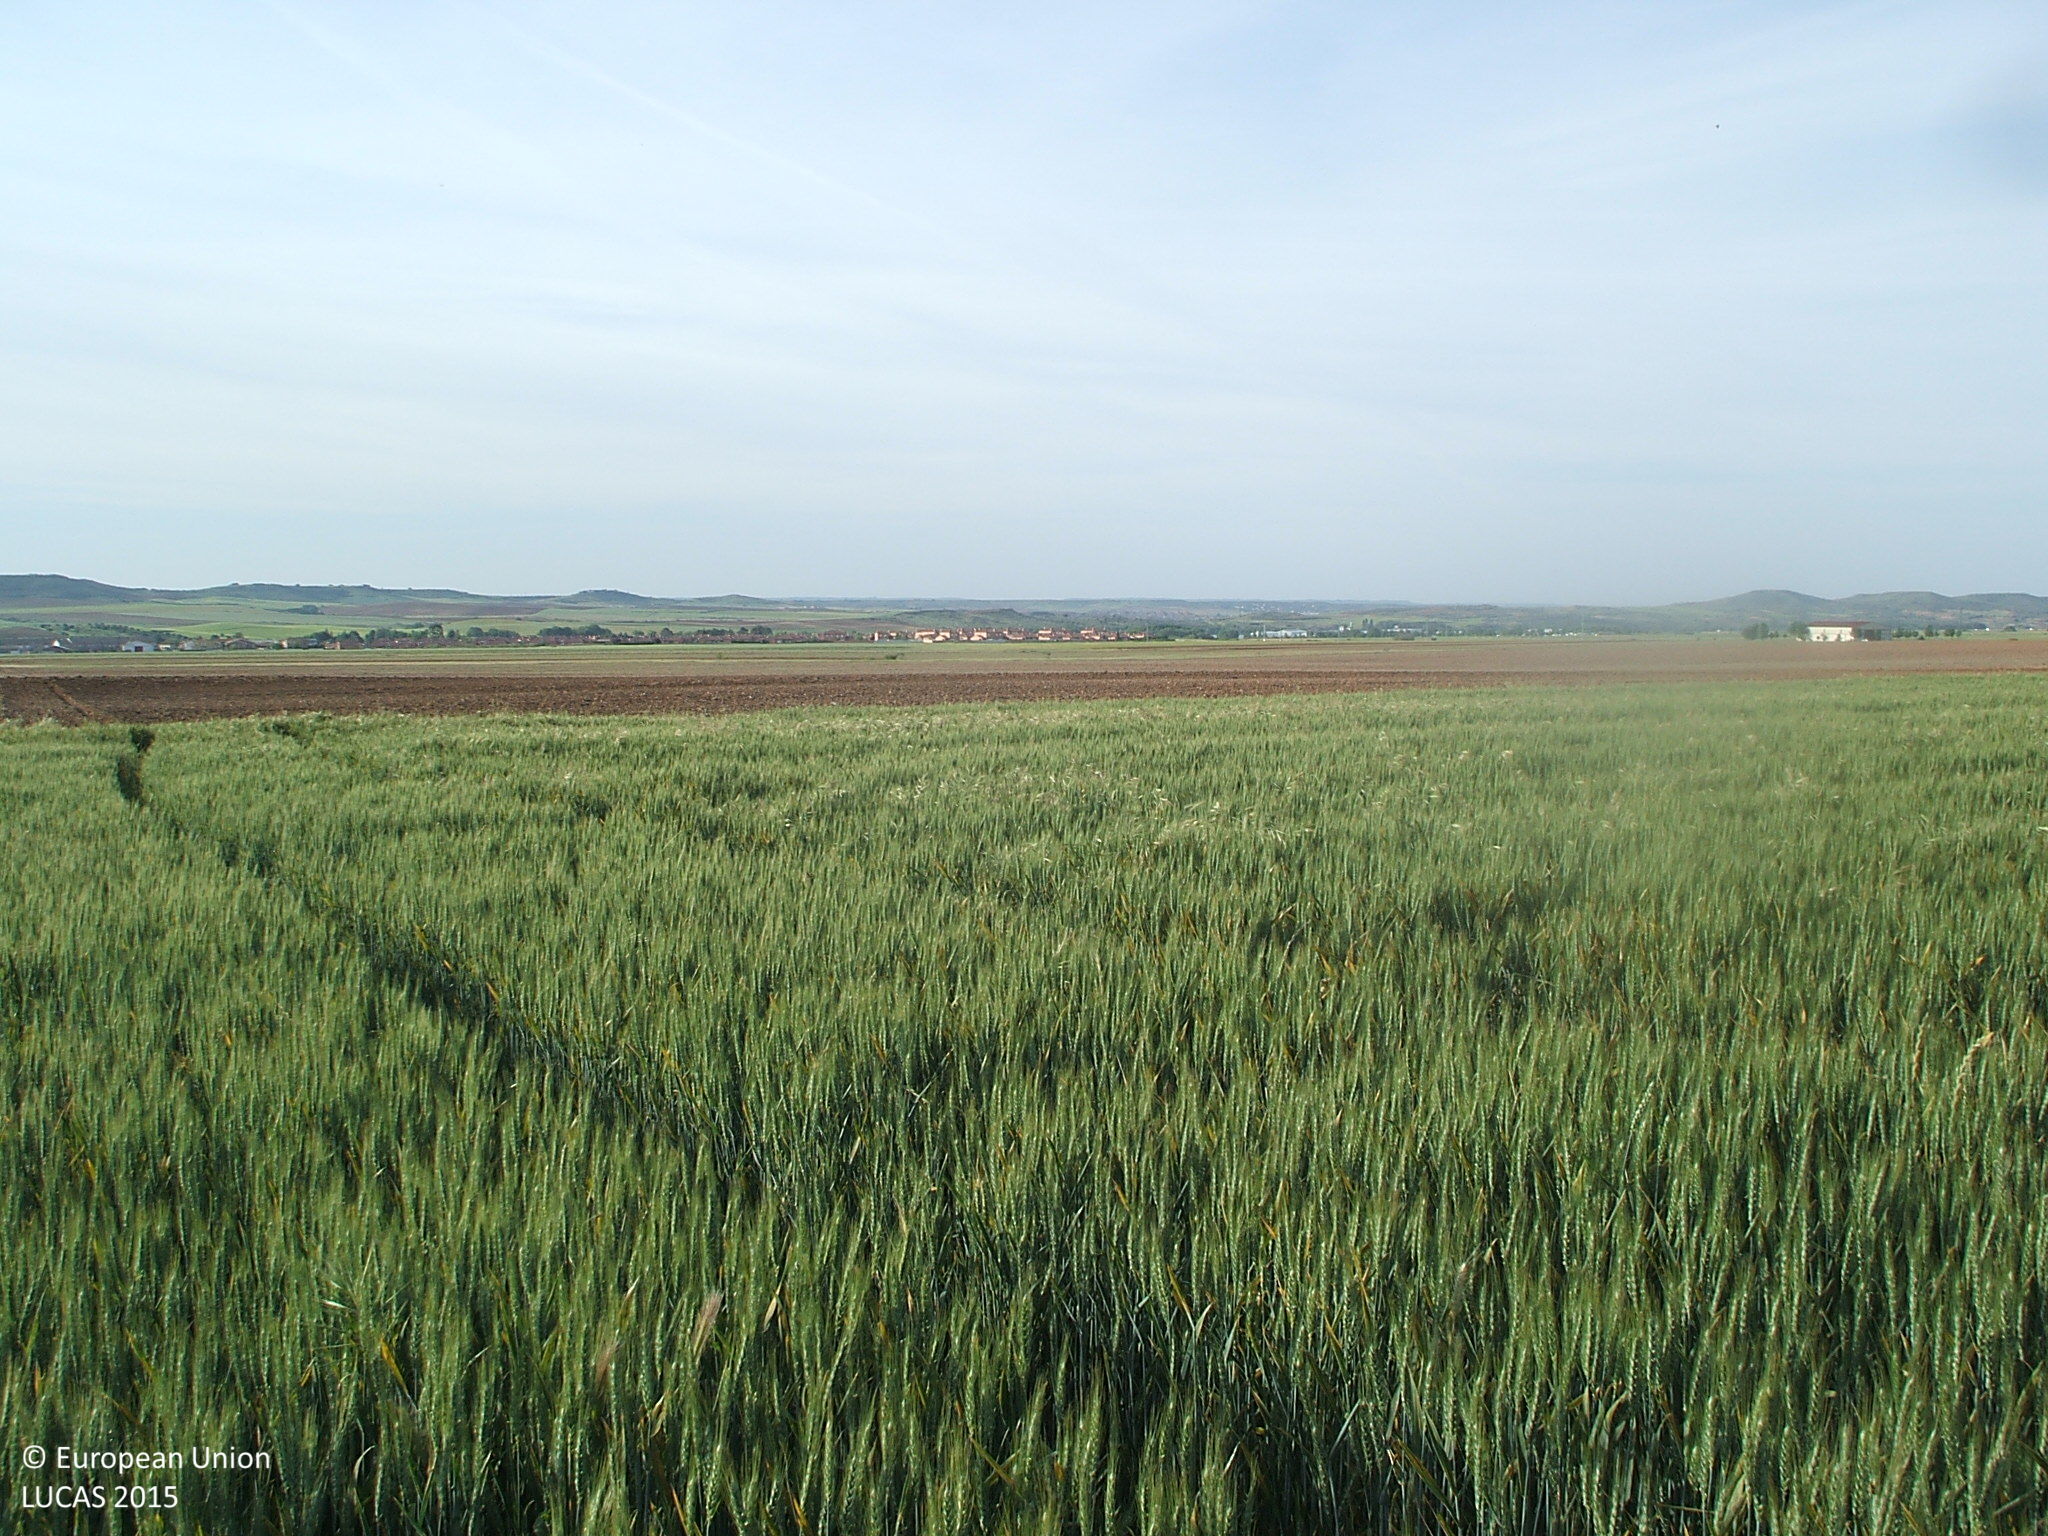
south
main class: Cropland
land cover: Common wheat
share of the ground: > 75 %
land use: Agriculture (excluding fallow land and kitchen gardens)
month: May
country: ES
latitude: 40.7048
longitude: -3.3519
